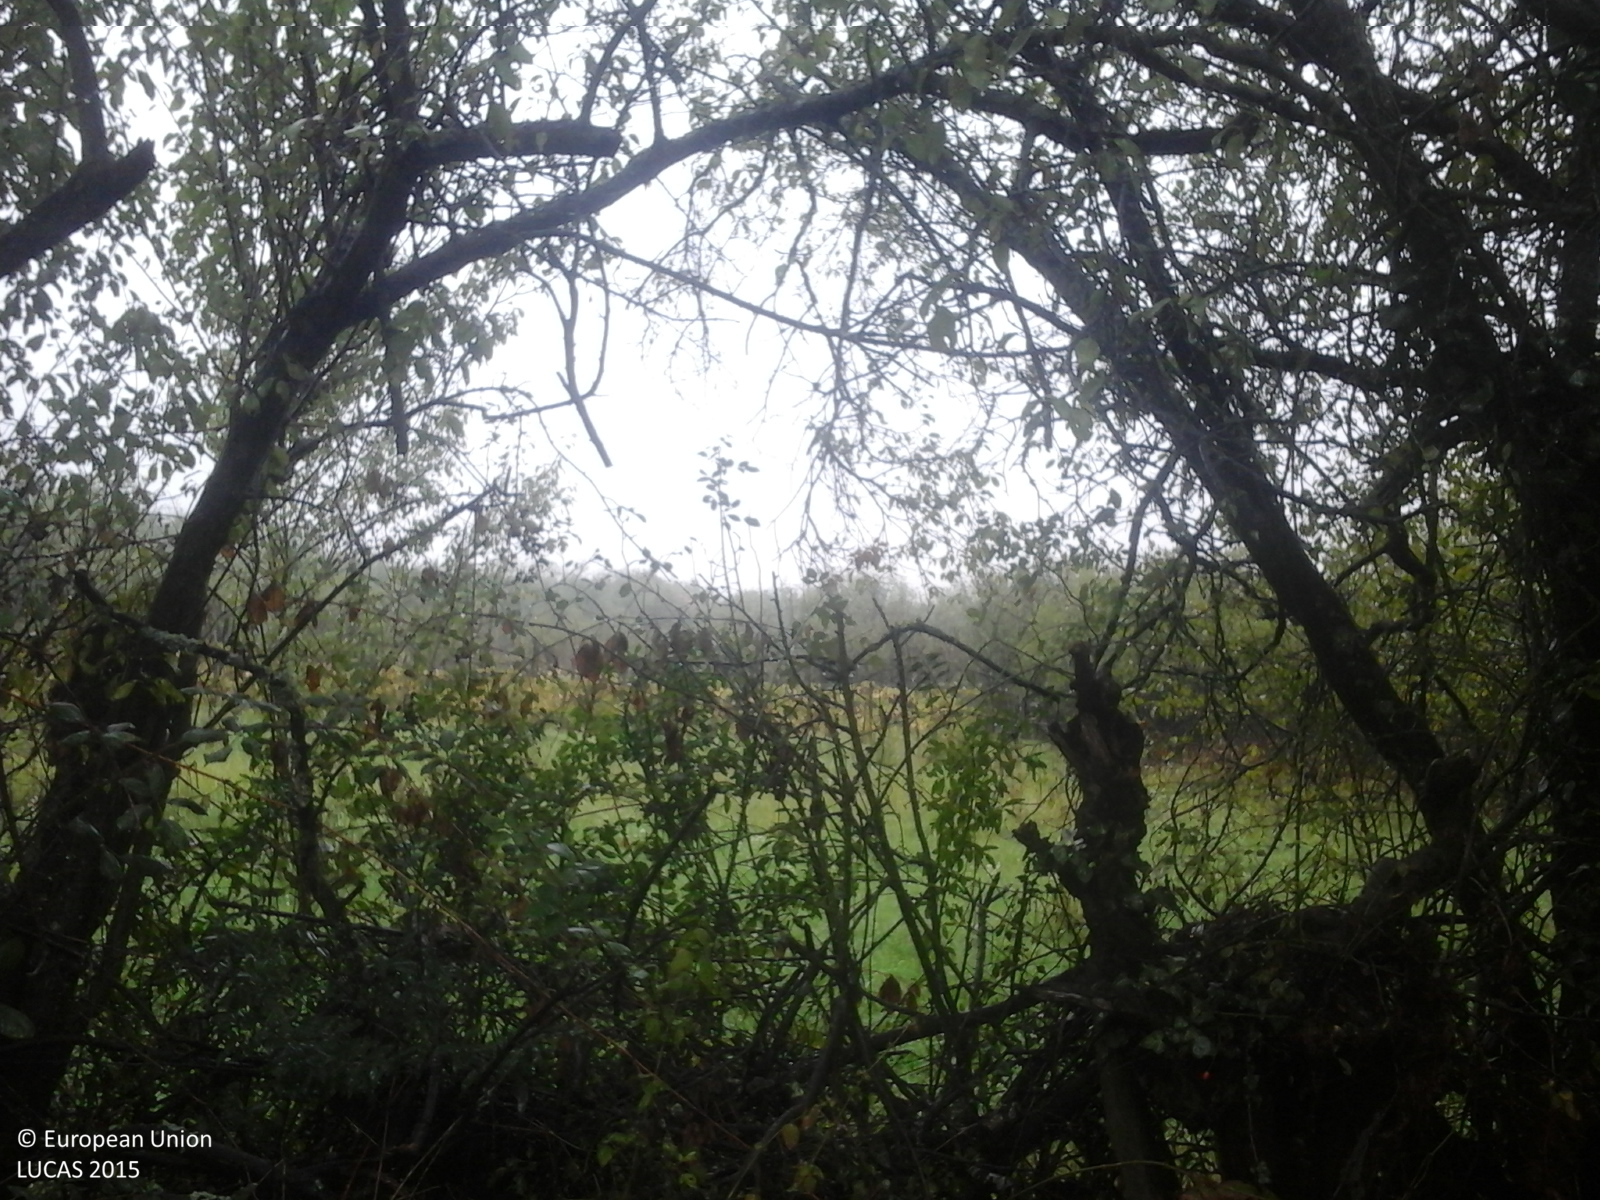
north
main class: Cropland
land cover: Vineyards
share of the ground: > 75 %
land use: Agriculture (excluding fallow land and kitchen gardens)
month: September
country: RO
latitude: 44.8332
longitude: 23.5022
